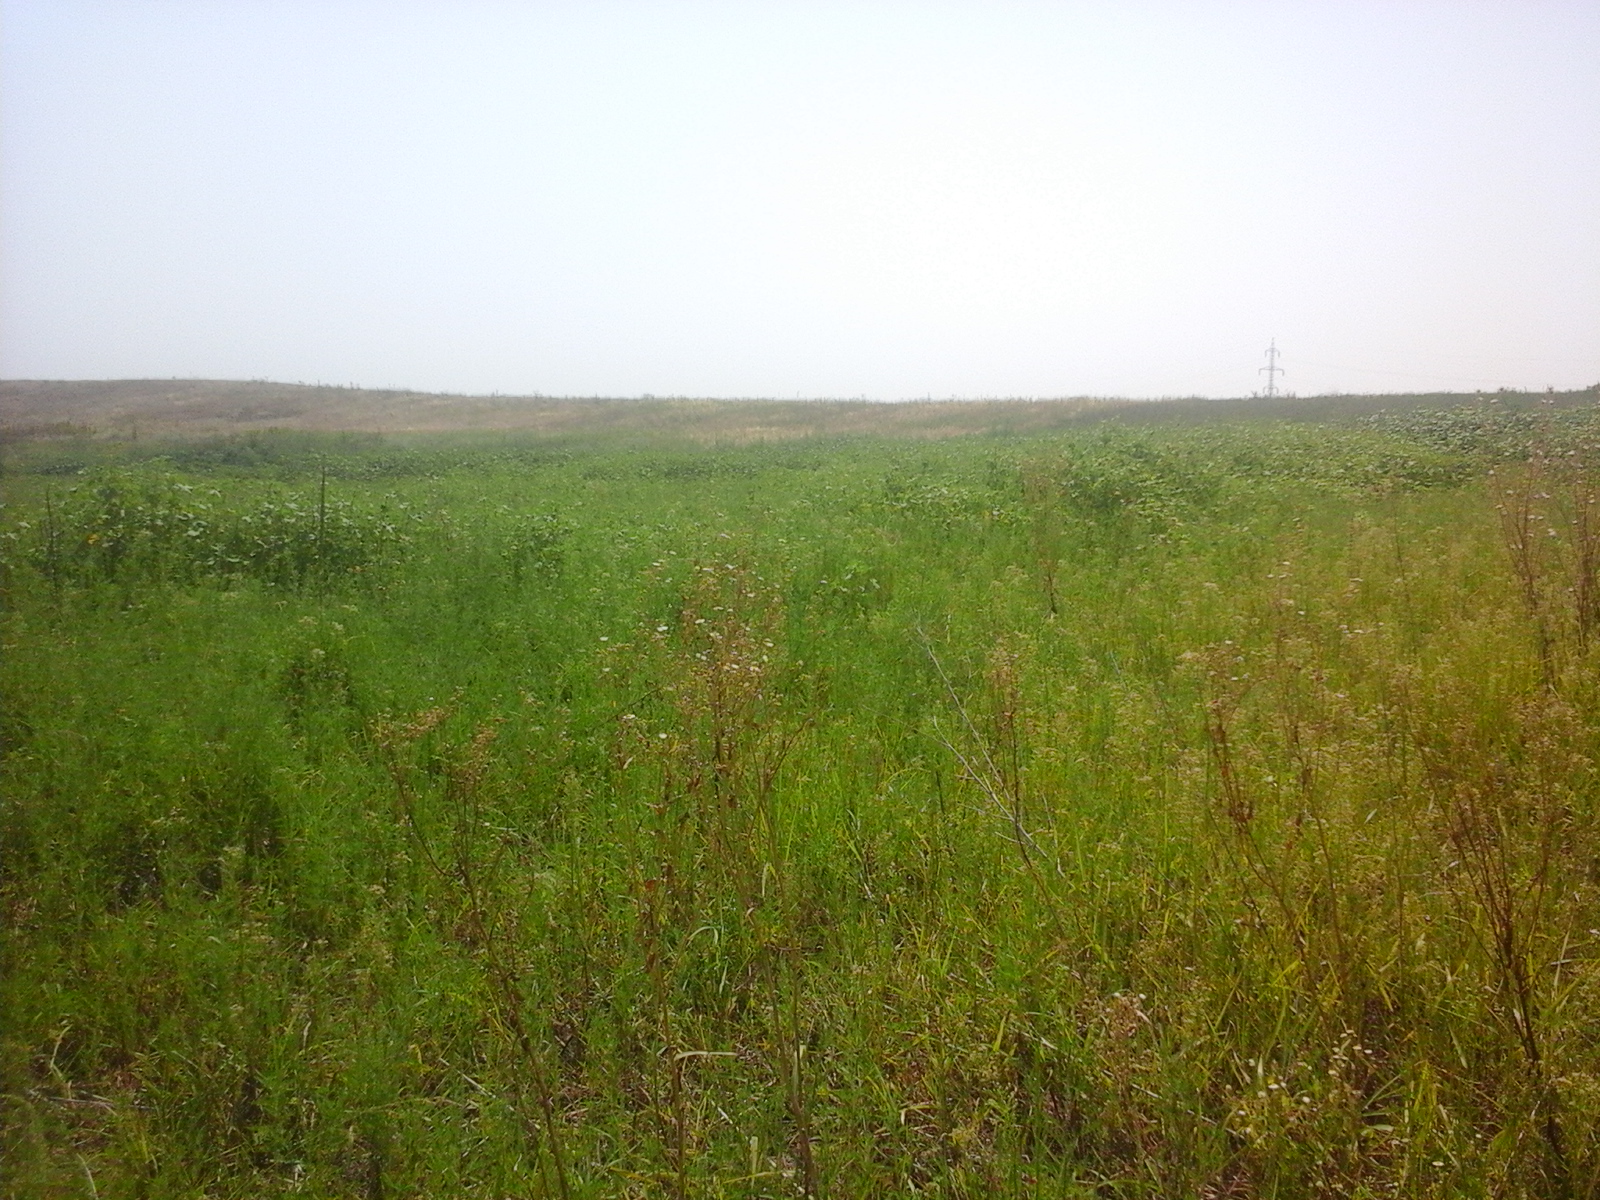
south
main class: Grassland
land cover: Spontaneously vegetated surfaces
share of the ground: > 75 %
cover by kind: herbaceous plants 100 %
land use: Fallow land
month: August
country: RO
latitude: 44.3811
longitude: 22.6029
